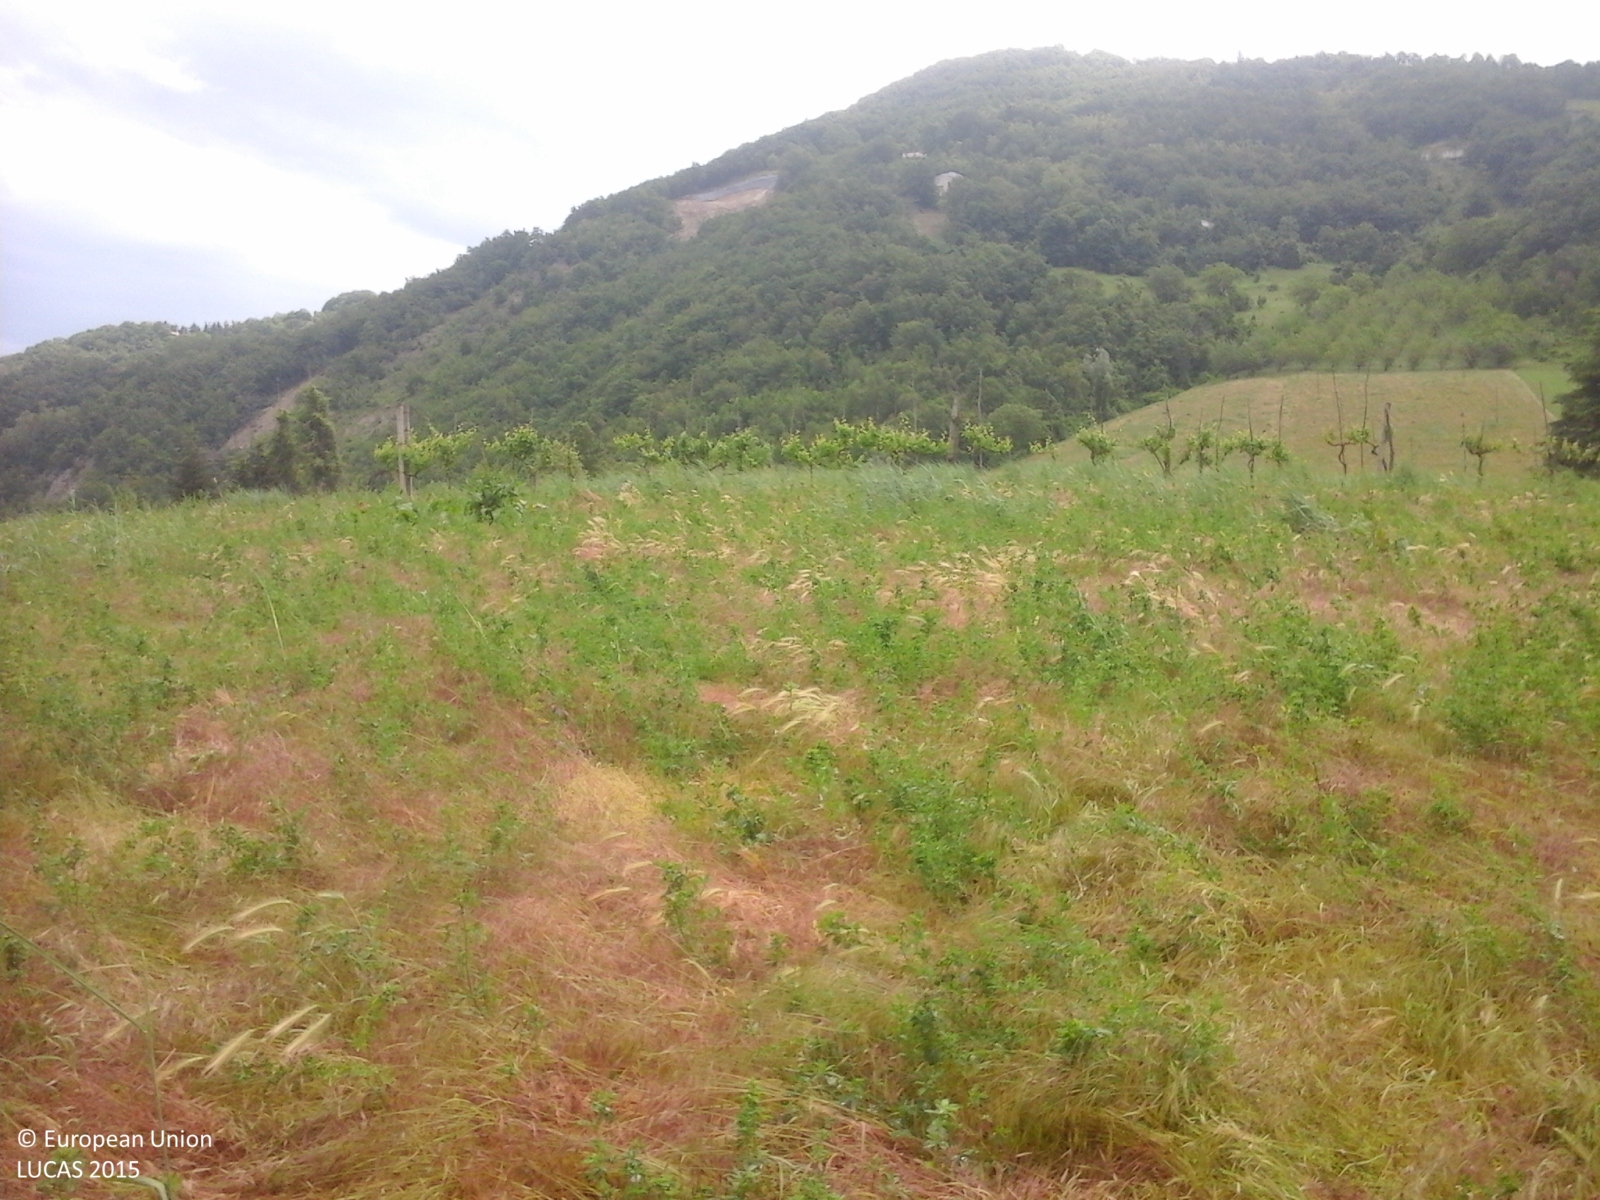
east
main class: Woodland
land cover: Broadleaved woodland
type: thermophilous deciduous forest
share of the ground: > 75 %
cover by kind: broadleaved forest trees 90 %, shrubs 10 %
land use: Semi-natural and natural areas not in use
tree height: > 5 m
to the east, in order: Broadleaved woodland; Shrubland with sparse tree cover; Lucerne; Grass margins; Vineyards; Grass margins; Lucerne; Vineyards; Lucerne
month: May
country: IT
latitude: 44.2926
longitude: 10.8878
